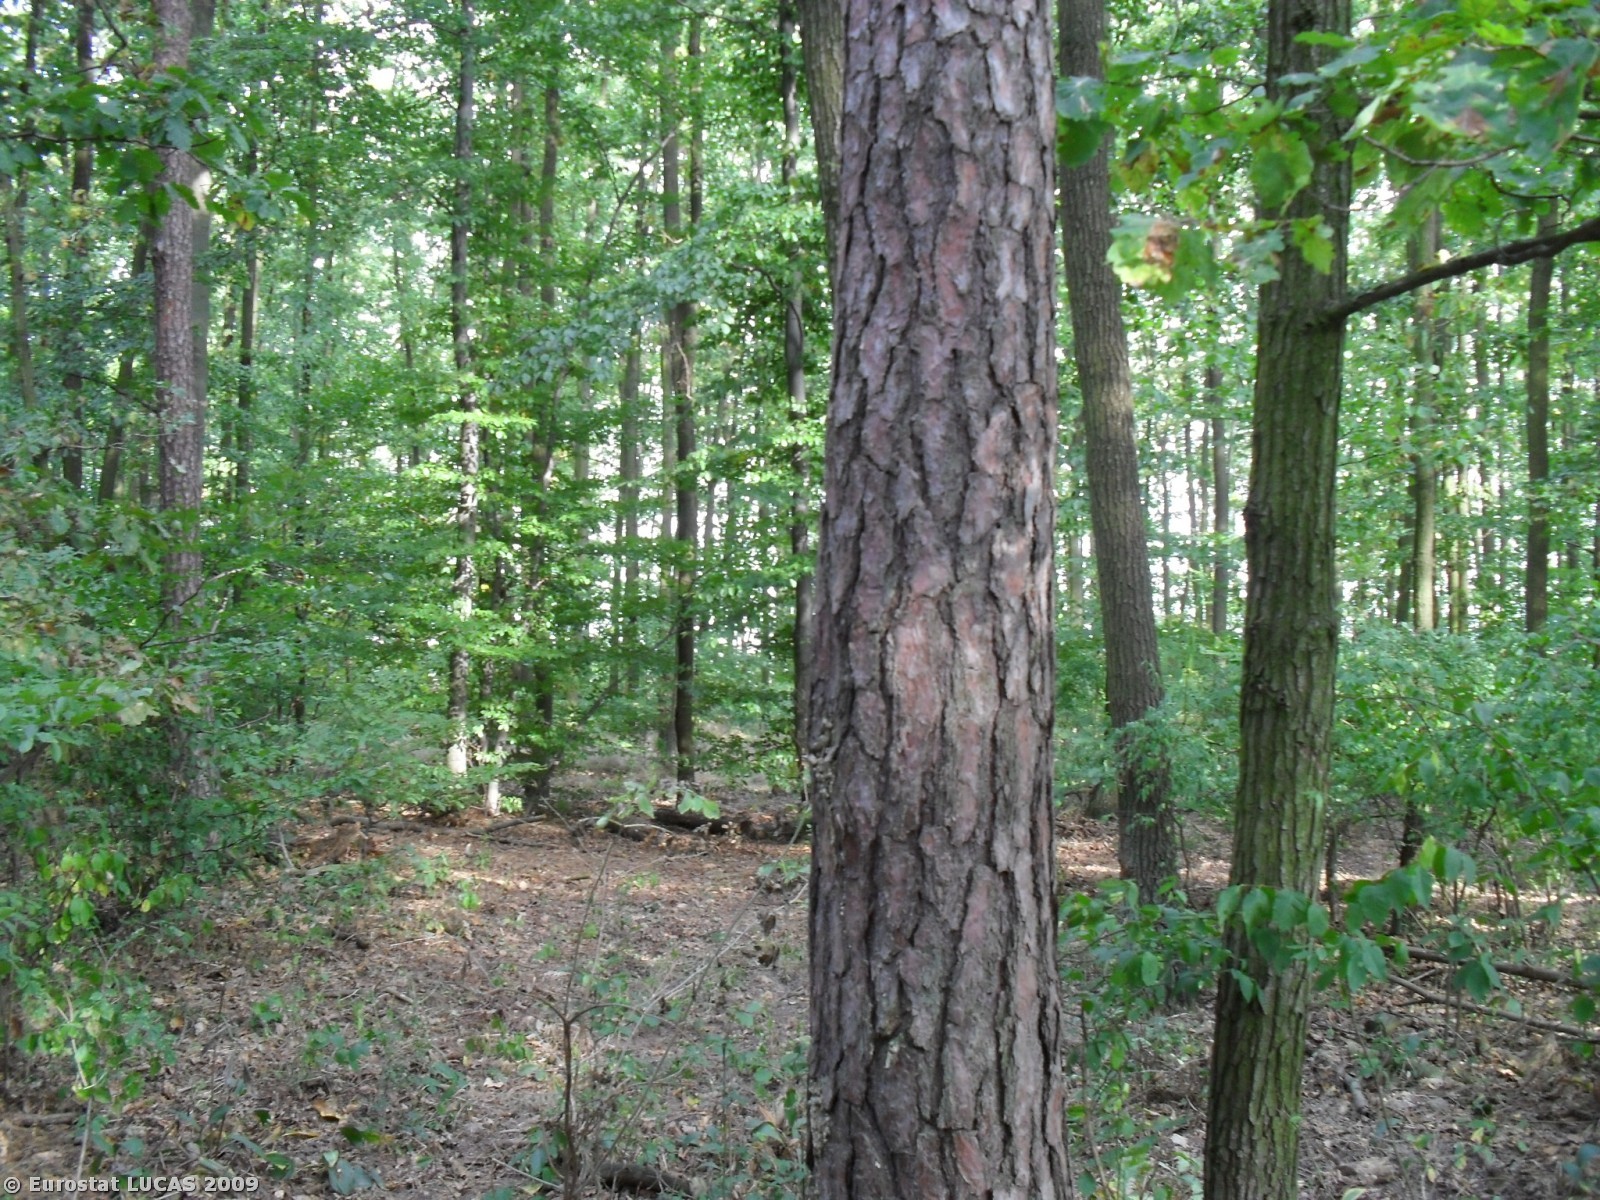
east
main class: Woodland
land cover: Mixed woodland
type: hemiboreal forest and nemoral coniferous forest and mixed broadleaved-coniferous forest
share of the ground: > 75 %
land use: Forestry
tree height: > 5 m
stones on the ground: < 10 %
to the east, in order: Mixed woodland; Broadleaved woodland; Tracks; Rye; Grassland without tree/shrub cover
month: September
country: PL
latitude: 51.6571
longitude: 20.6943
